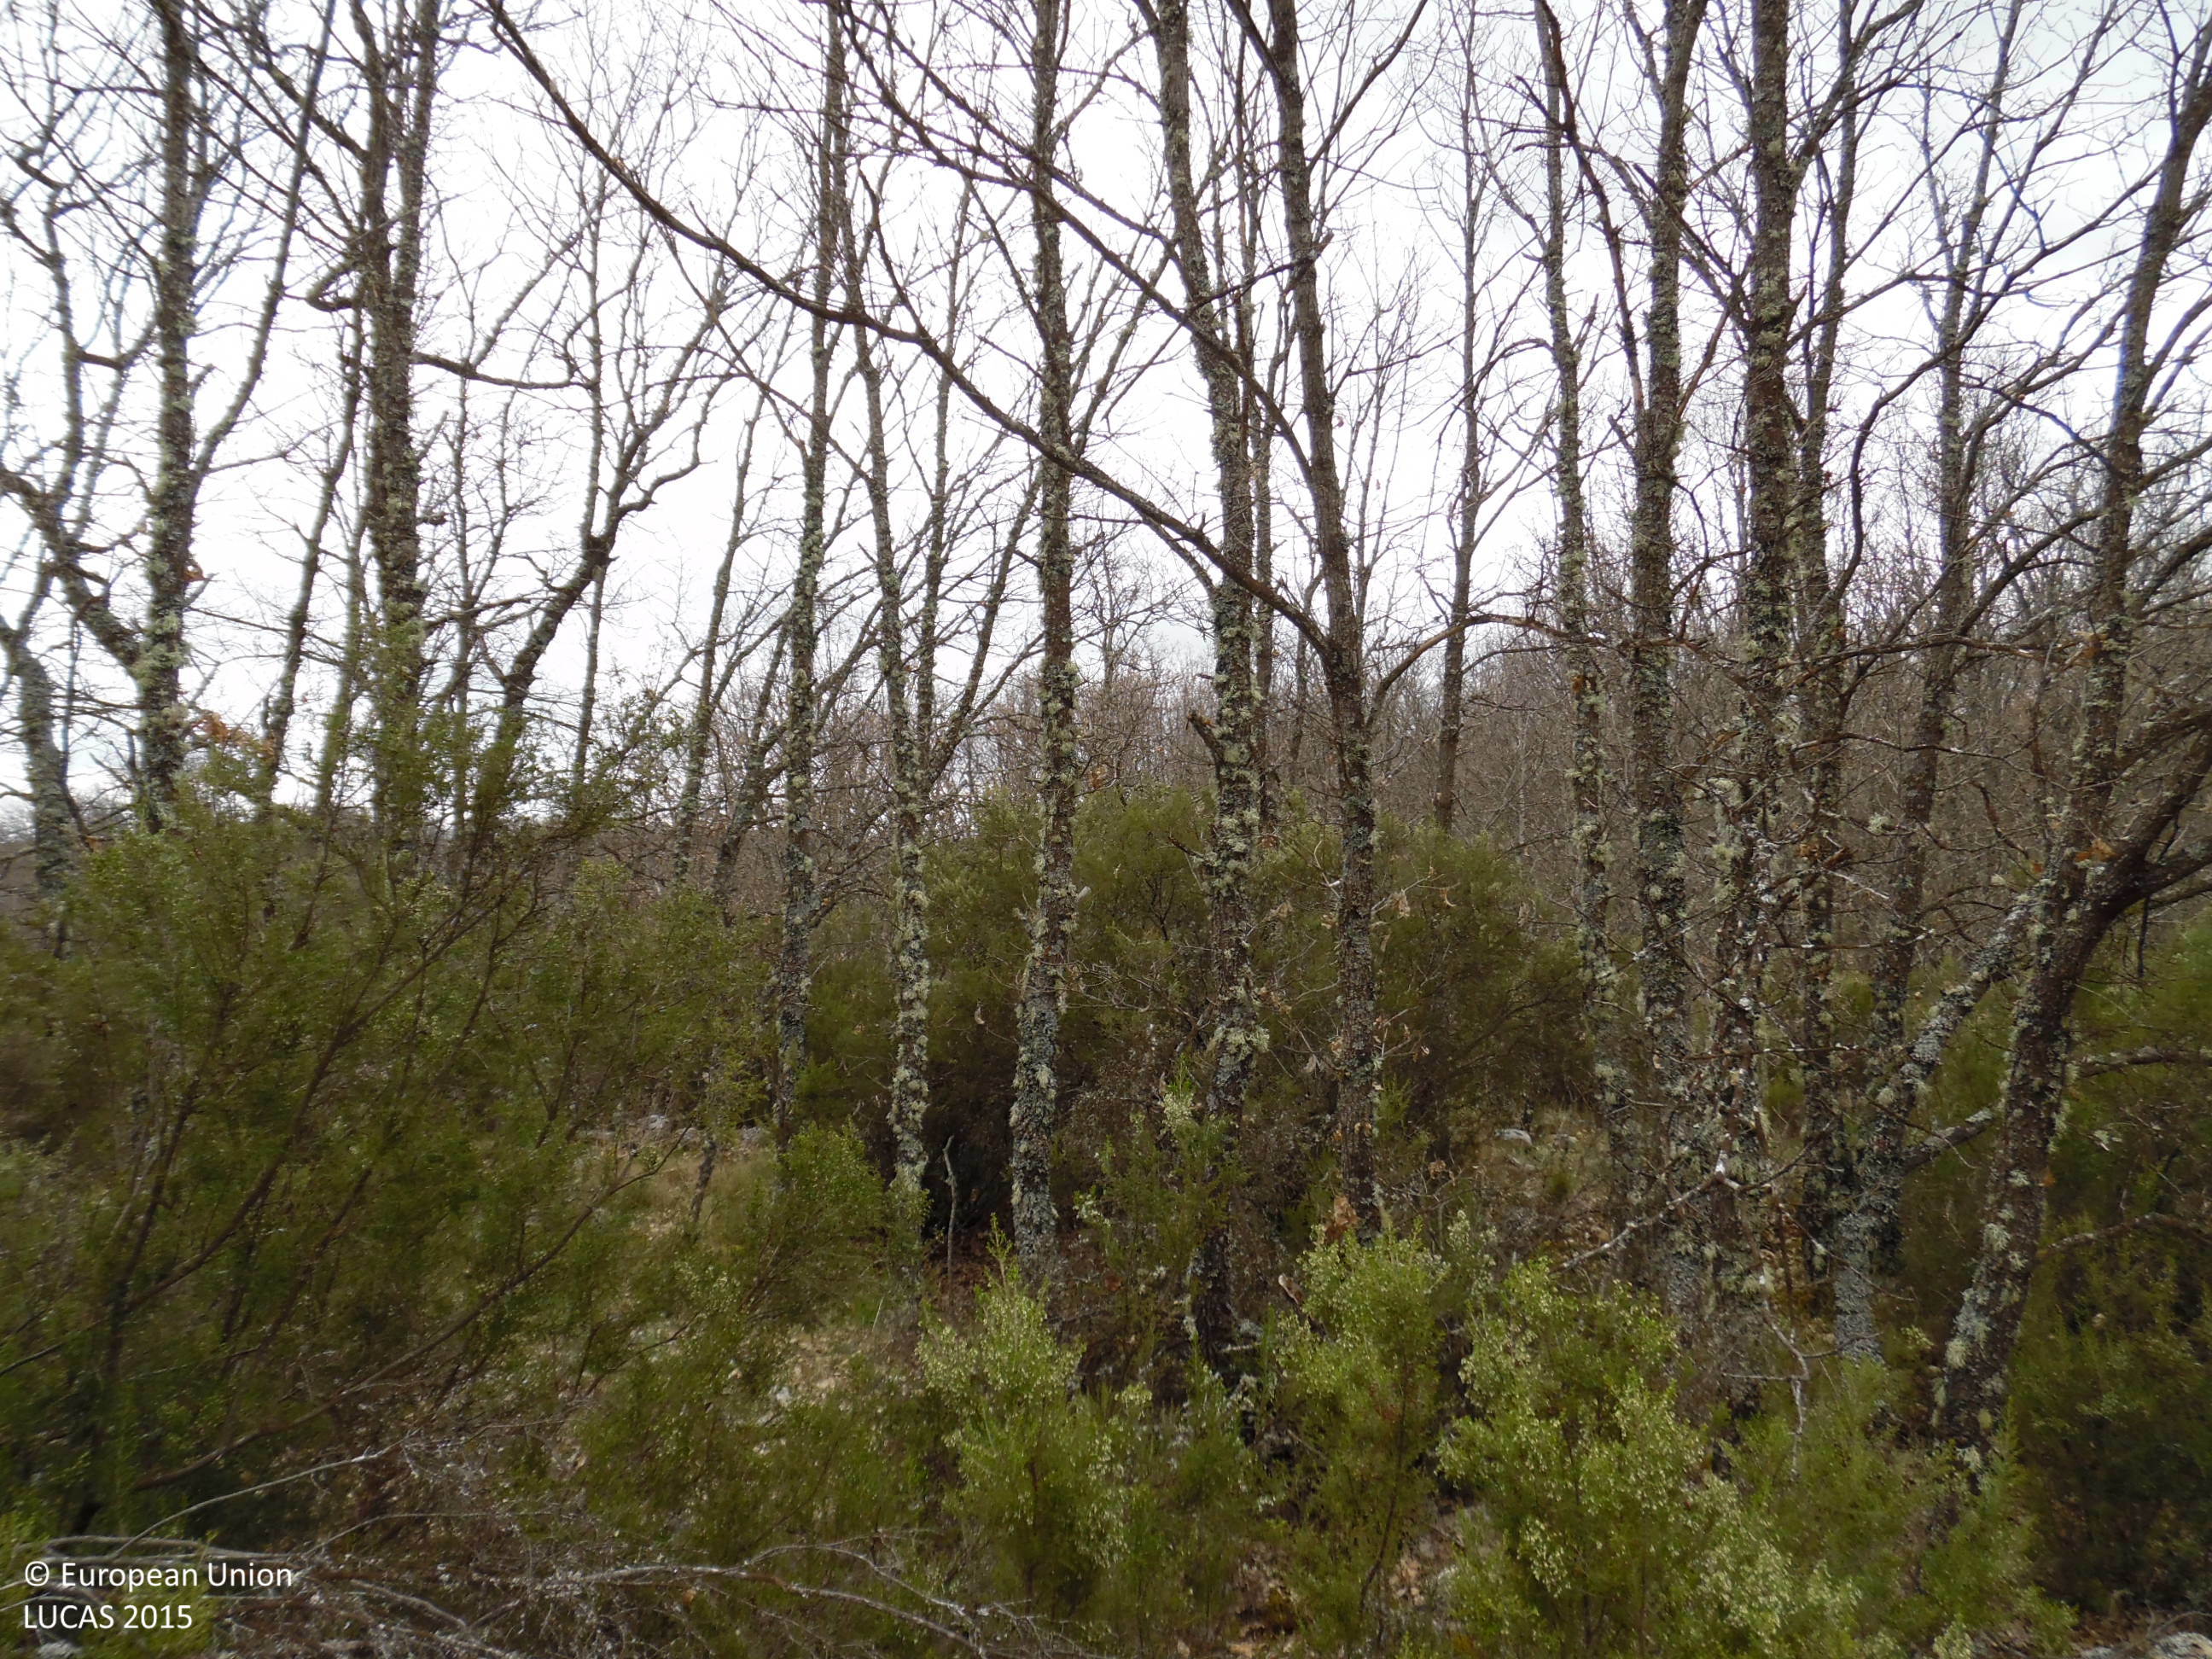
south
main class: Woodland
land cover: Broadleaved woodland
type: acidophilous oak and oak-birch forest
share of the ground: > 75 %
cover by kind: broadleaved forest trees 95 %, shrubs 5 %
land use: Forestry
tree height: > 5 m
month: April
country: ES
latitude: 42.3853
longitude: -6.3264
